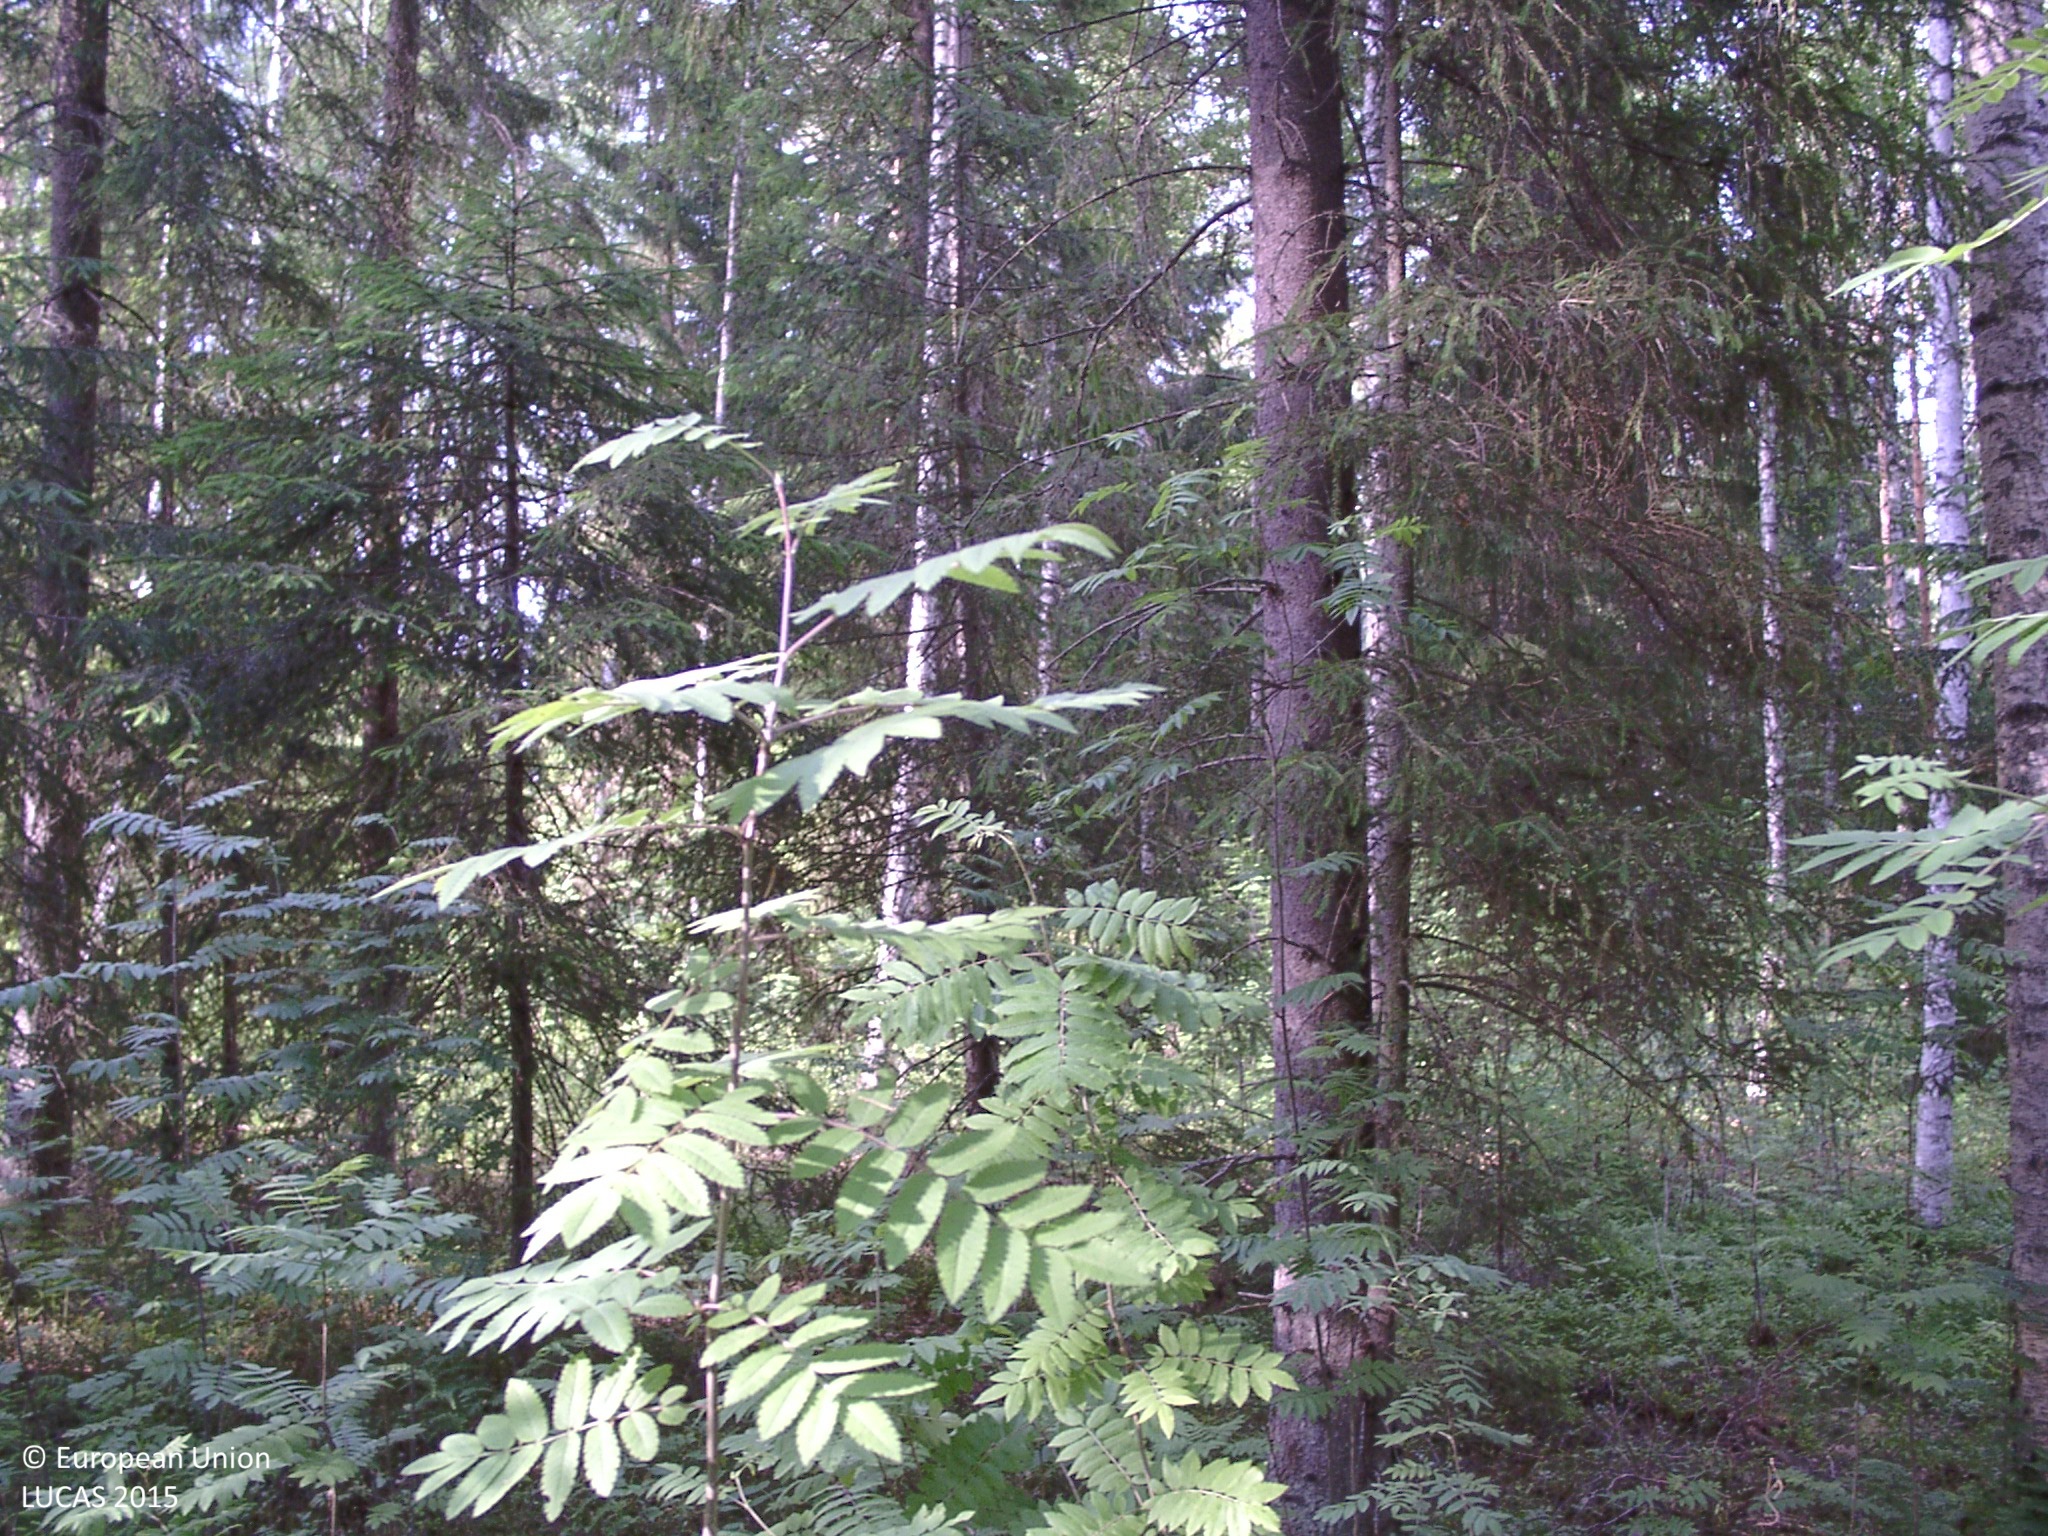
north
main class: Woodland
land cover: Other mixed woodland
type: boreal forest
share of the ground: 50 - 75 %
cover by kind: coniferous forest trees 35 %, broadleaved forest trees 35 %, shrubs 30 %
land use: Semi-natural and natural areas not in use
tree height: > 5 m
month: July
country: FI
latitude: 62.0180
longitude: 25.3784
